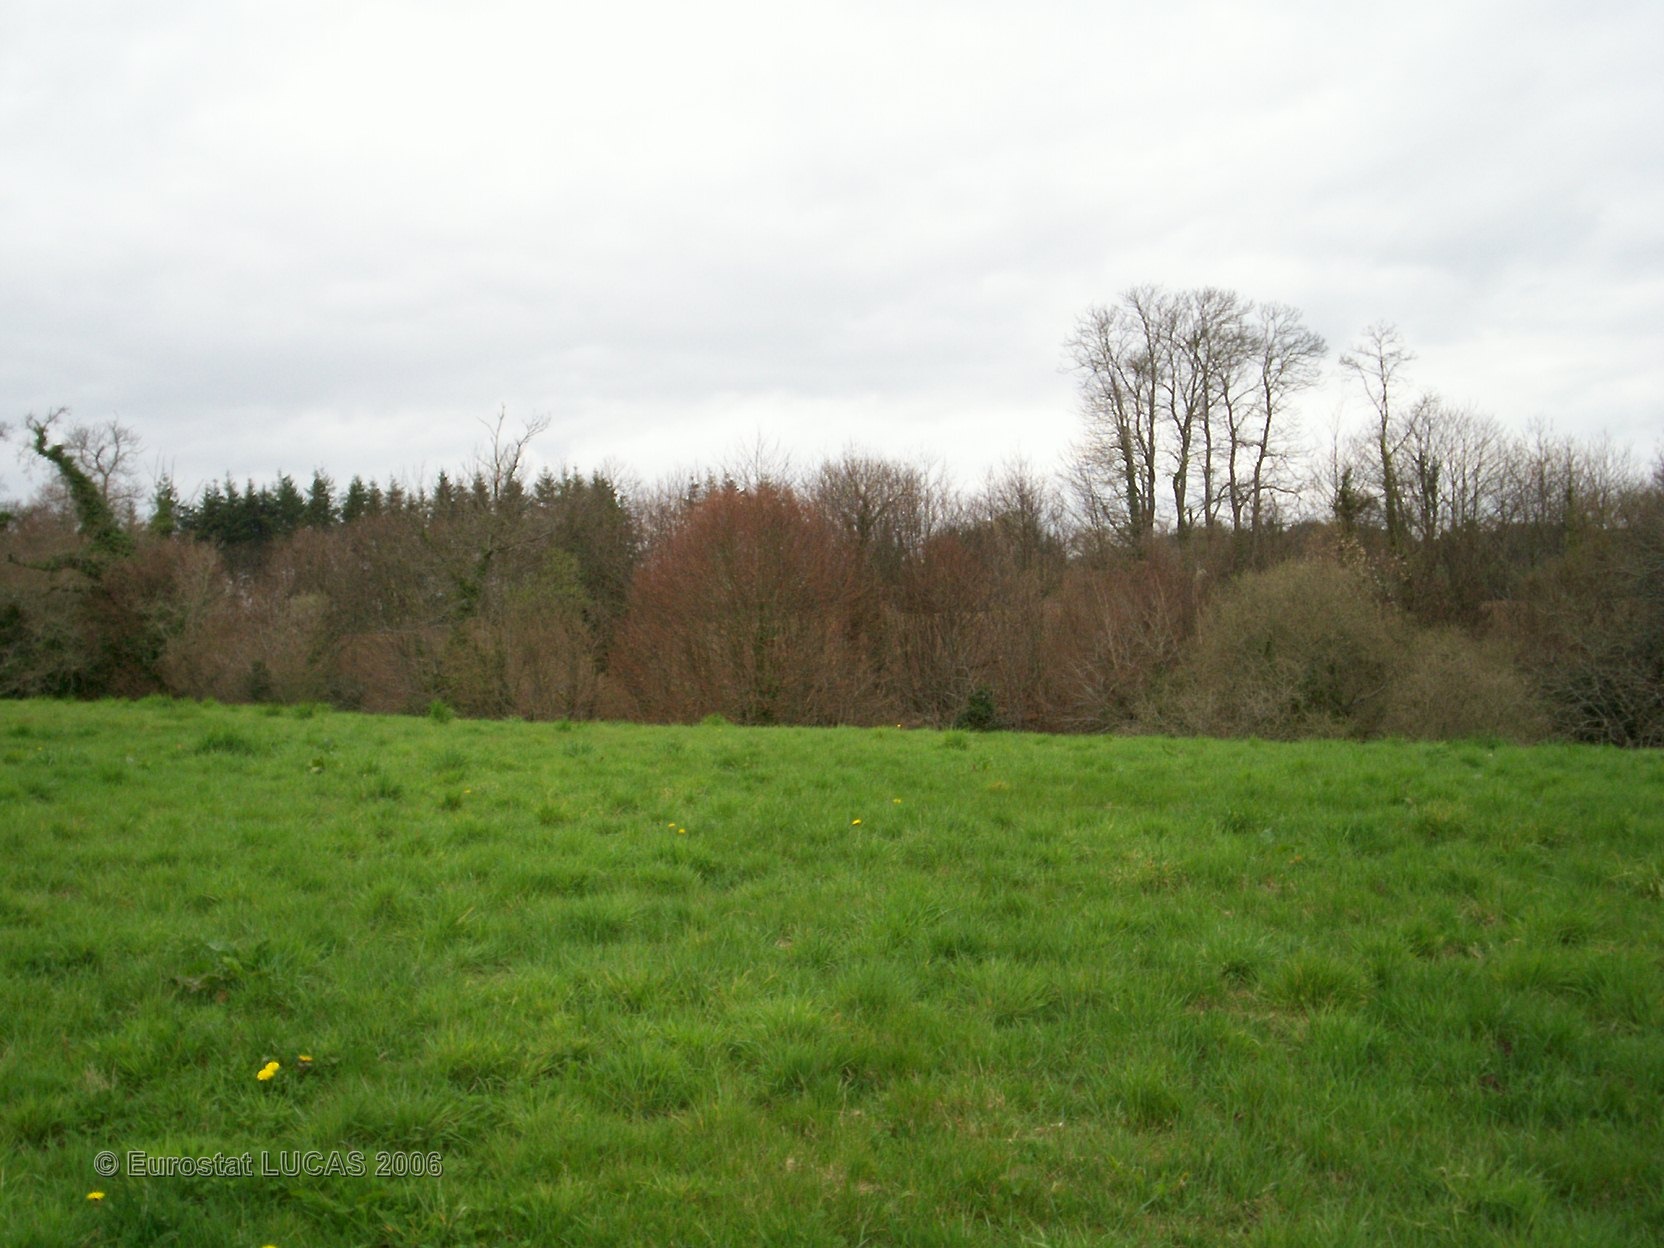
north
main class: Grassland
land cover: Grassland without tree/shrub cover
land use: Agriculture (excluding fallow land and kitchen gardens)
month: April
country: FR
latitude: 47.9883
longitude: -3.5166
